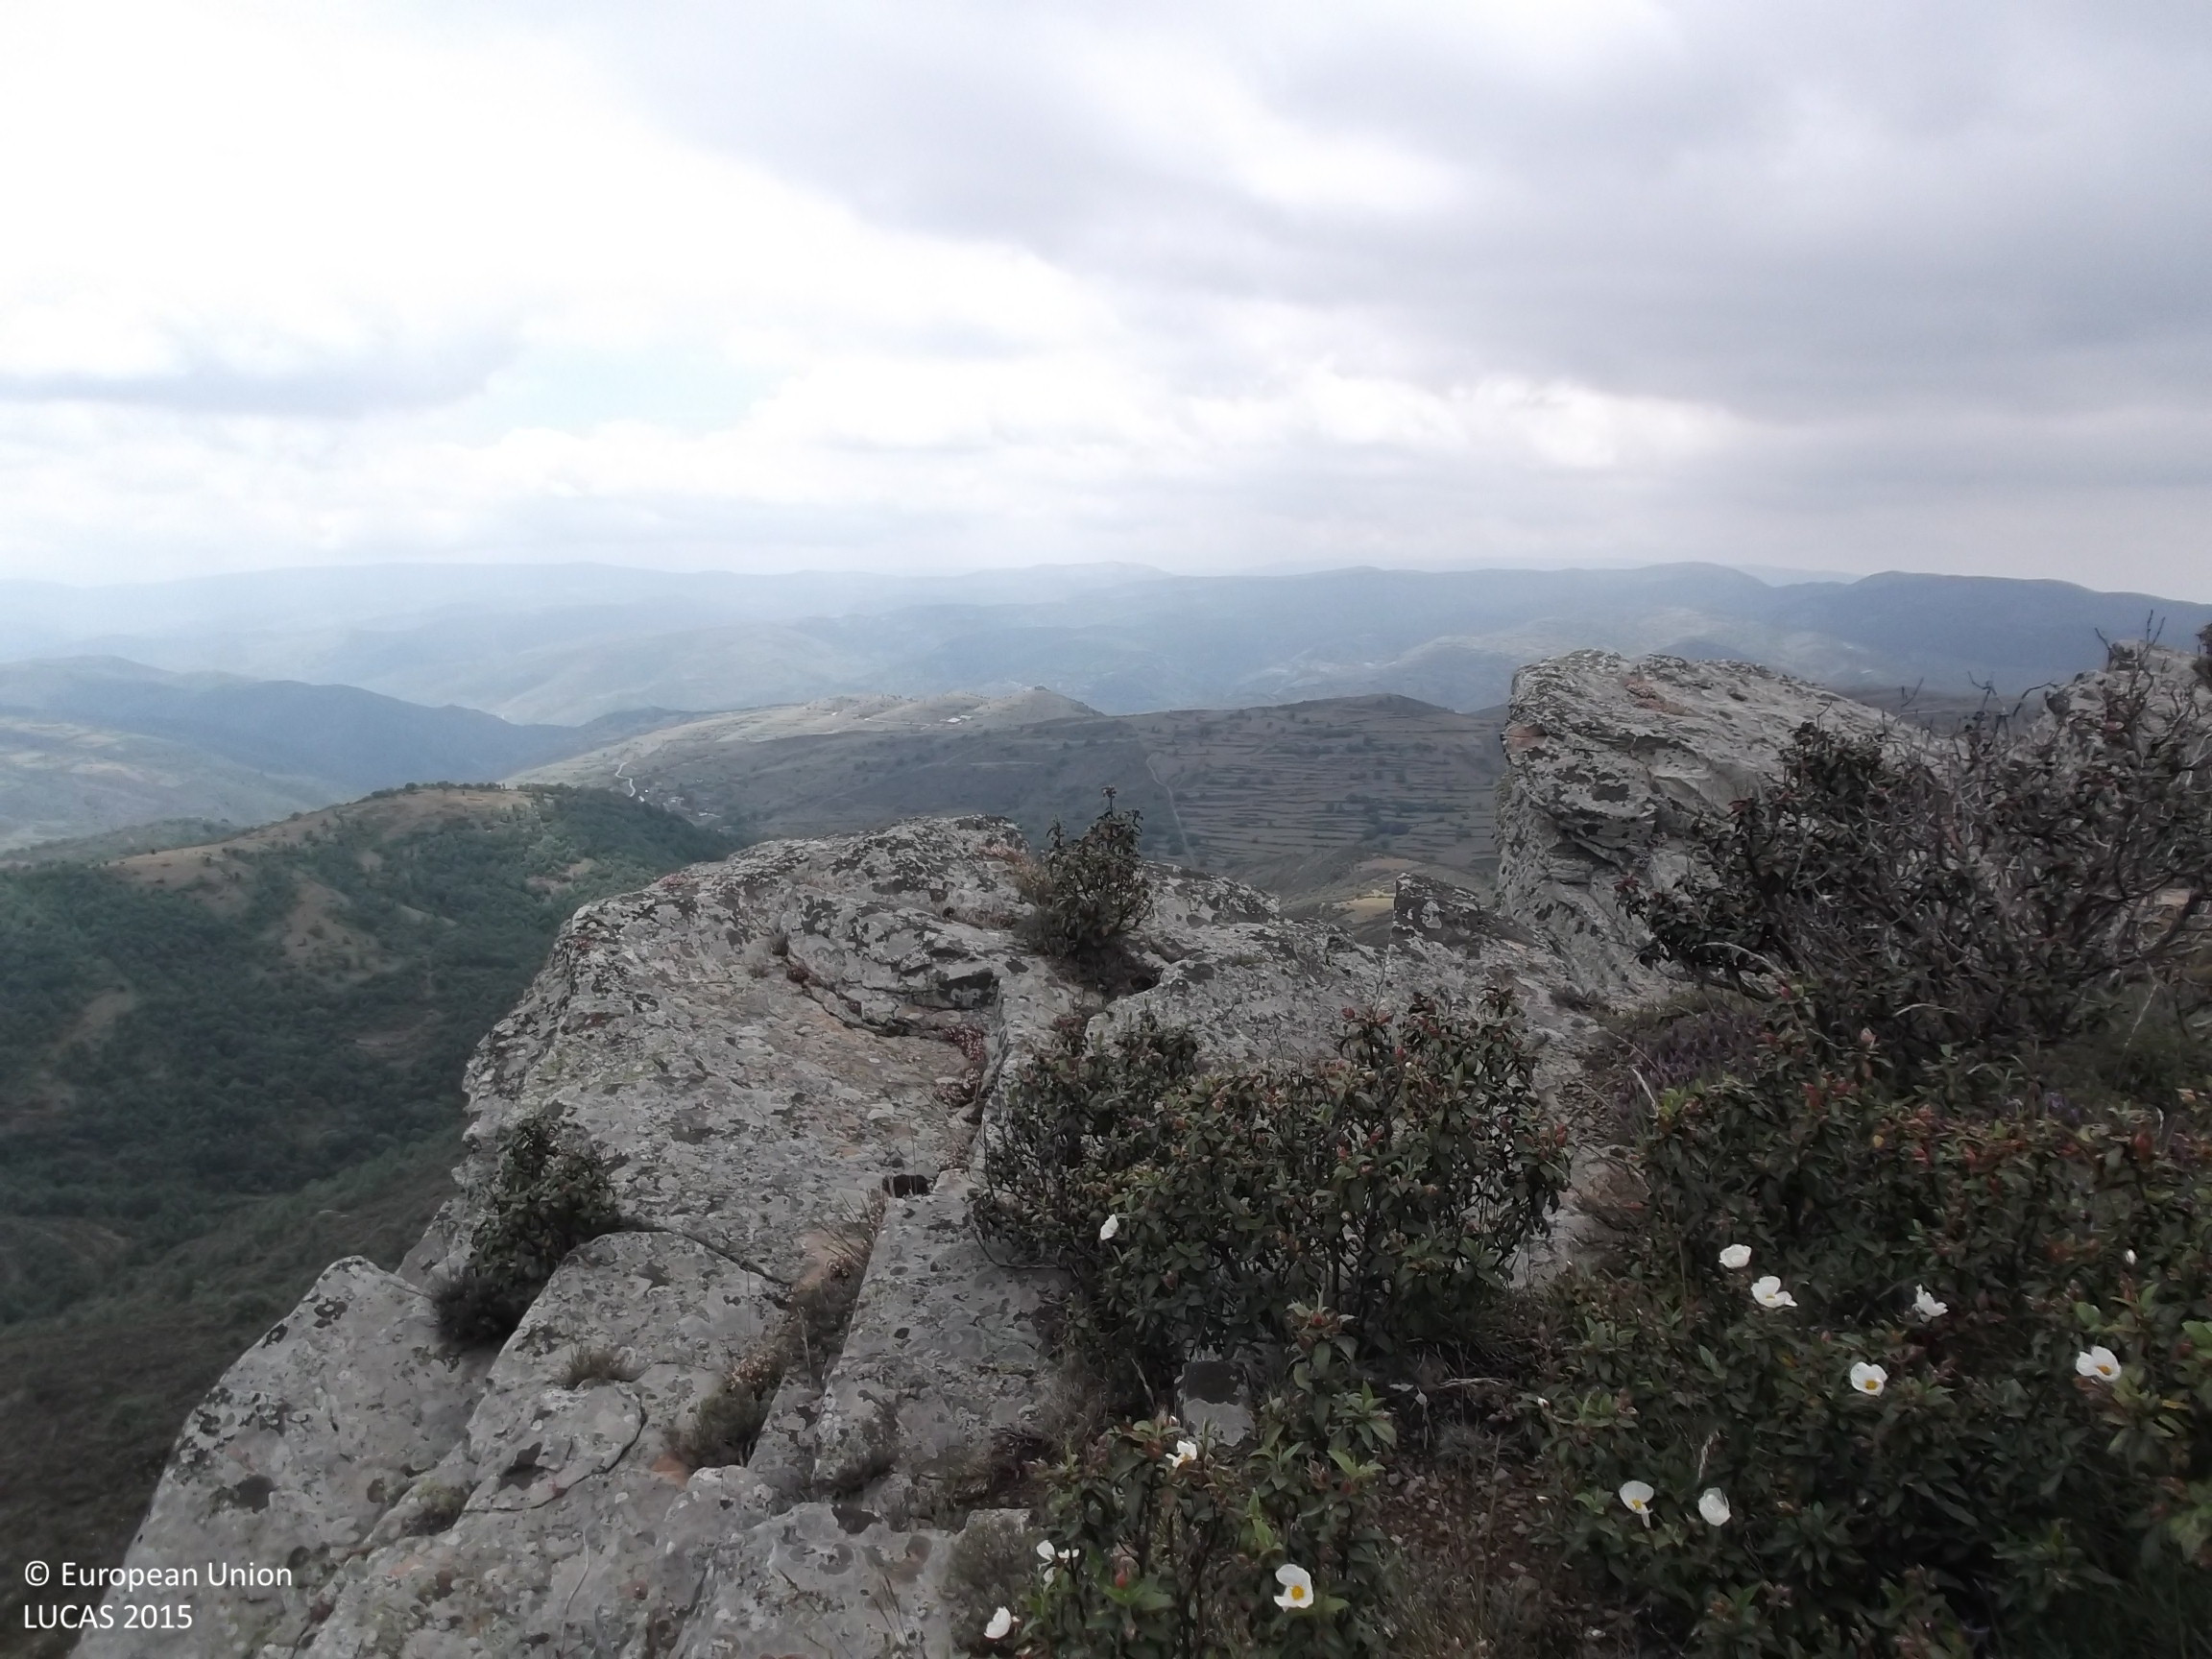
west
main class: Woodland
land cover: Broadleaved woodland
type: thermophilous deciduous forest
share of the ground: > 75 %
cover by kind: broadleaved forest trees 100 %
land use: Semi-natural and natural areas not in use
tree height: > 5 m
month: June
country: ES
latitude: 42.2547
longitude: -2.3936
